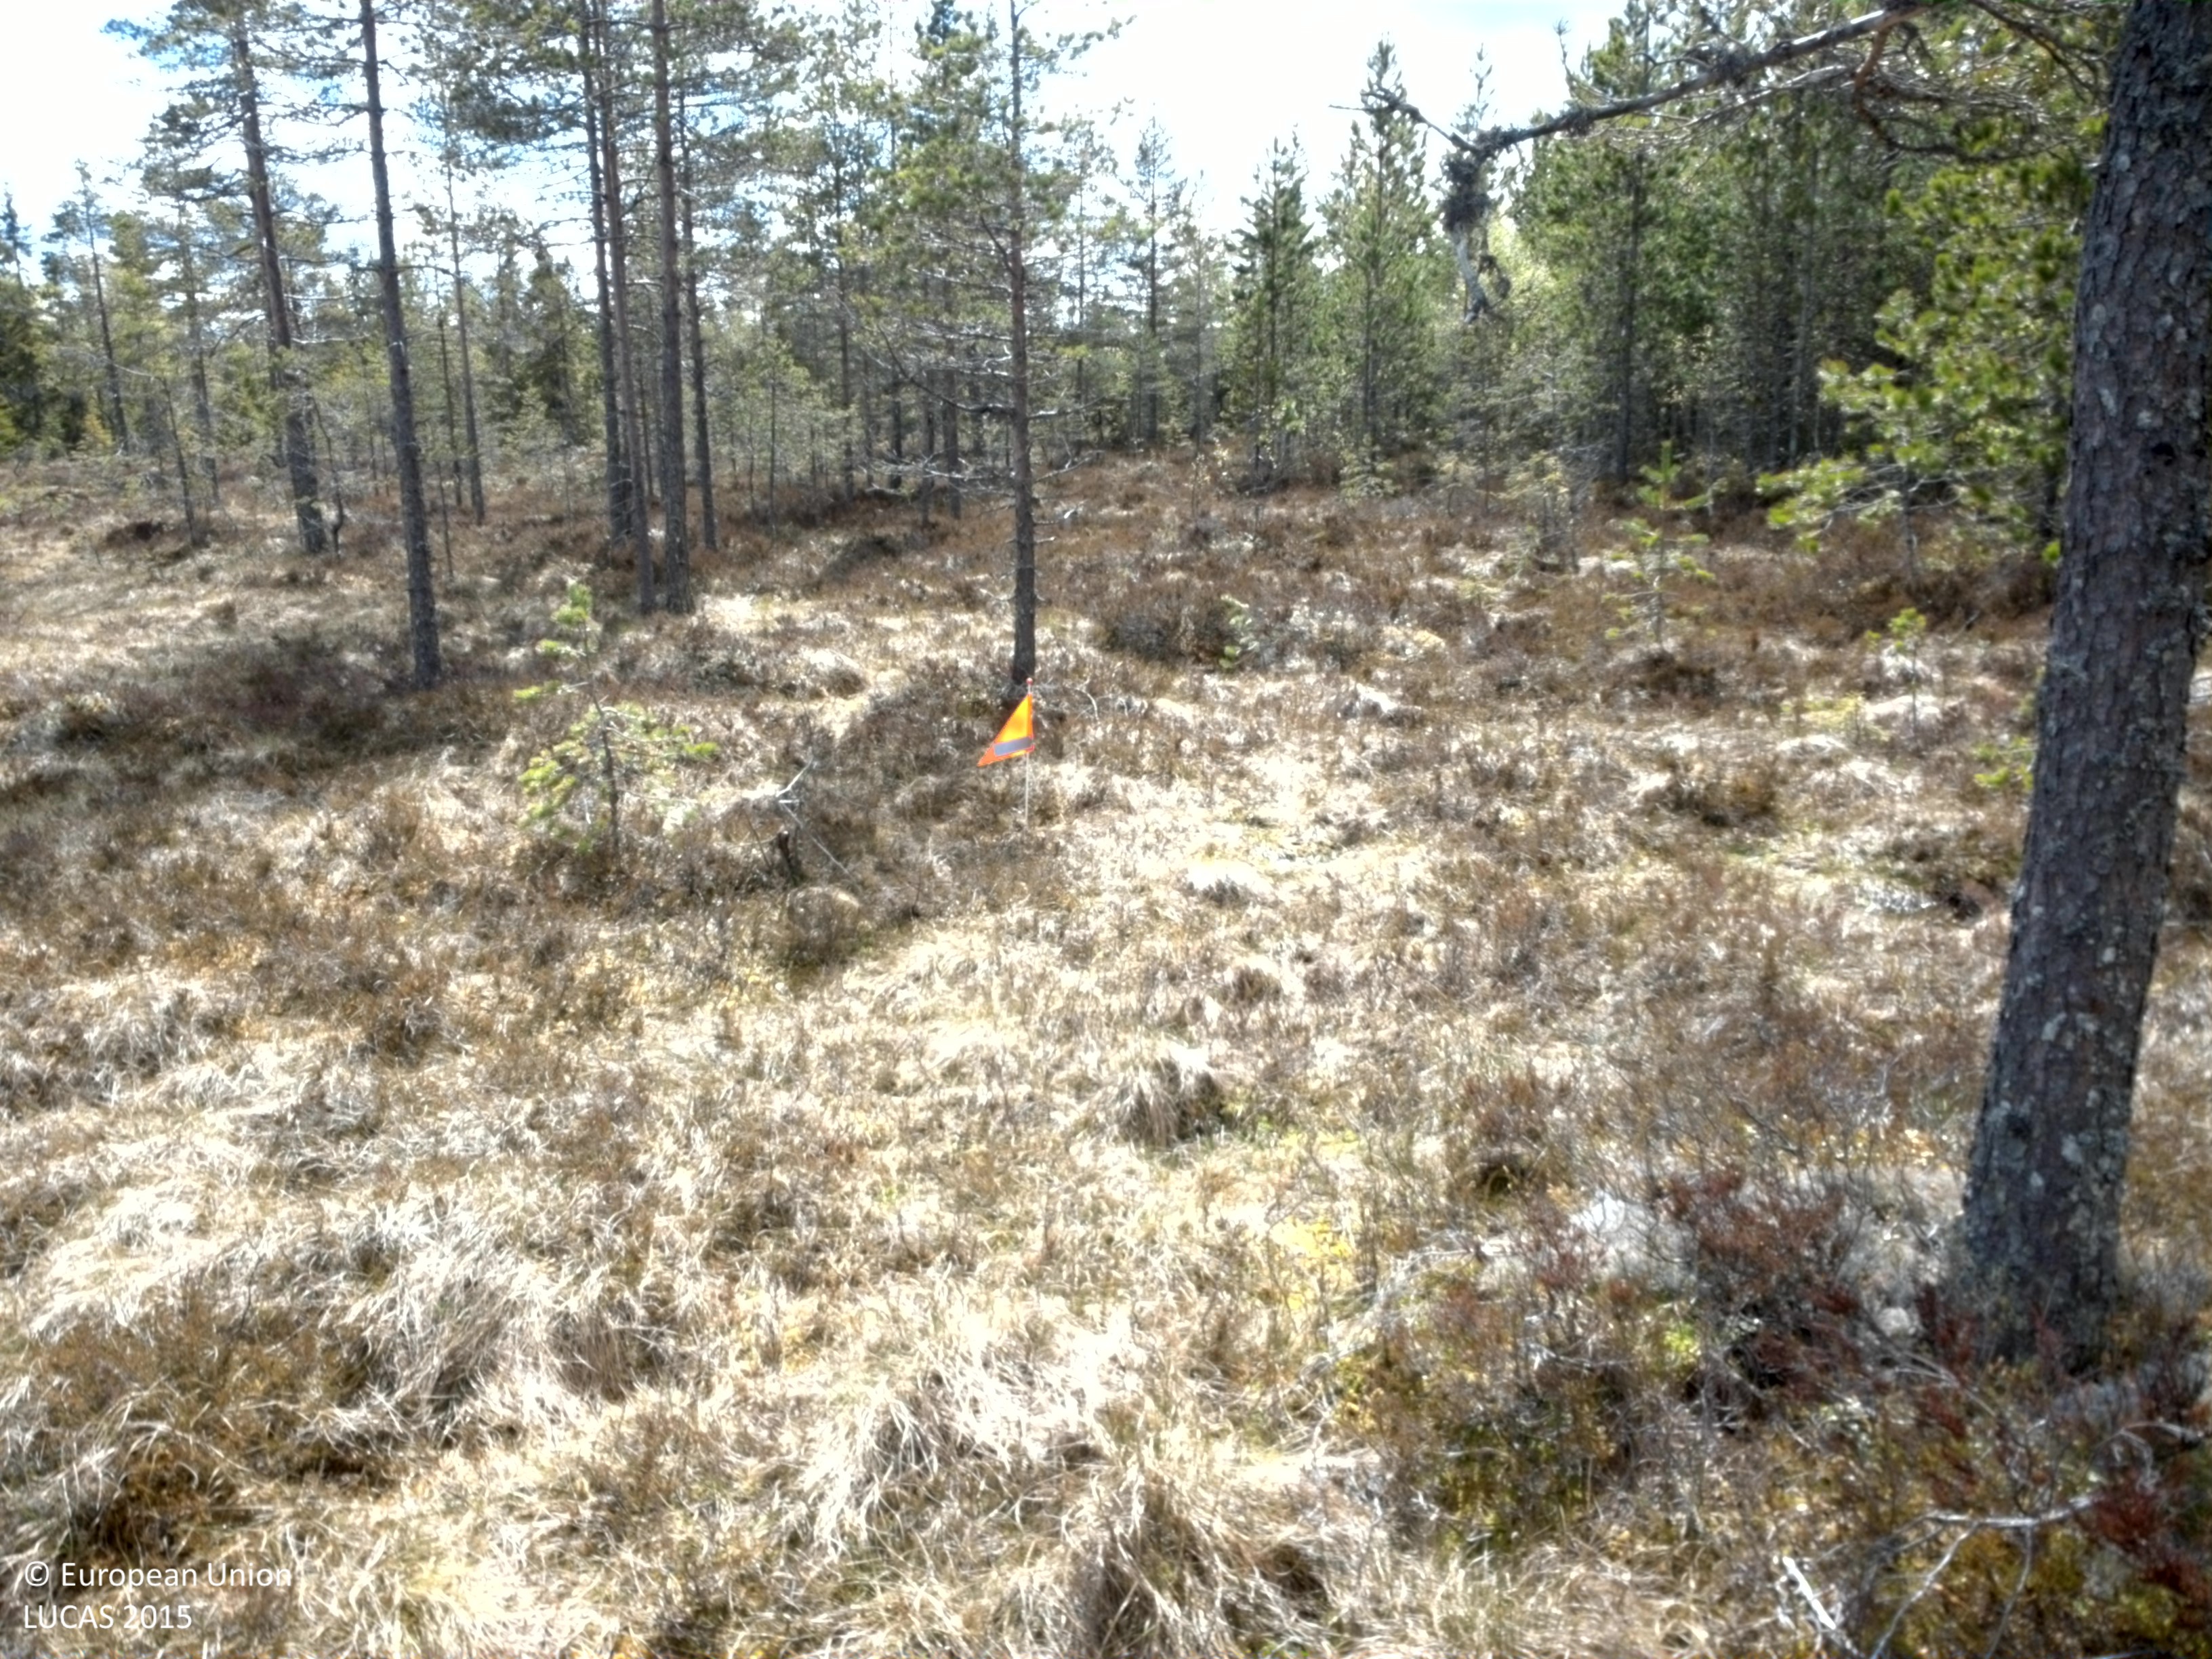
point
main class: Woodland
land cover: Pine dominated coniferous woodland
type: mire and swamp forests
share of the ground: 10 - 25 %
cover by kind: herbaceous plants 45 %, shrubs 40 %, coniferous forest trees 15 %
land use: Semi-natural and natural areas not in use
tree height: > 5 m
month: May
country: SE
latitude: 60.4059
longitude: 13.5659
